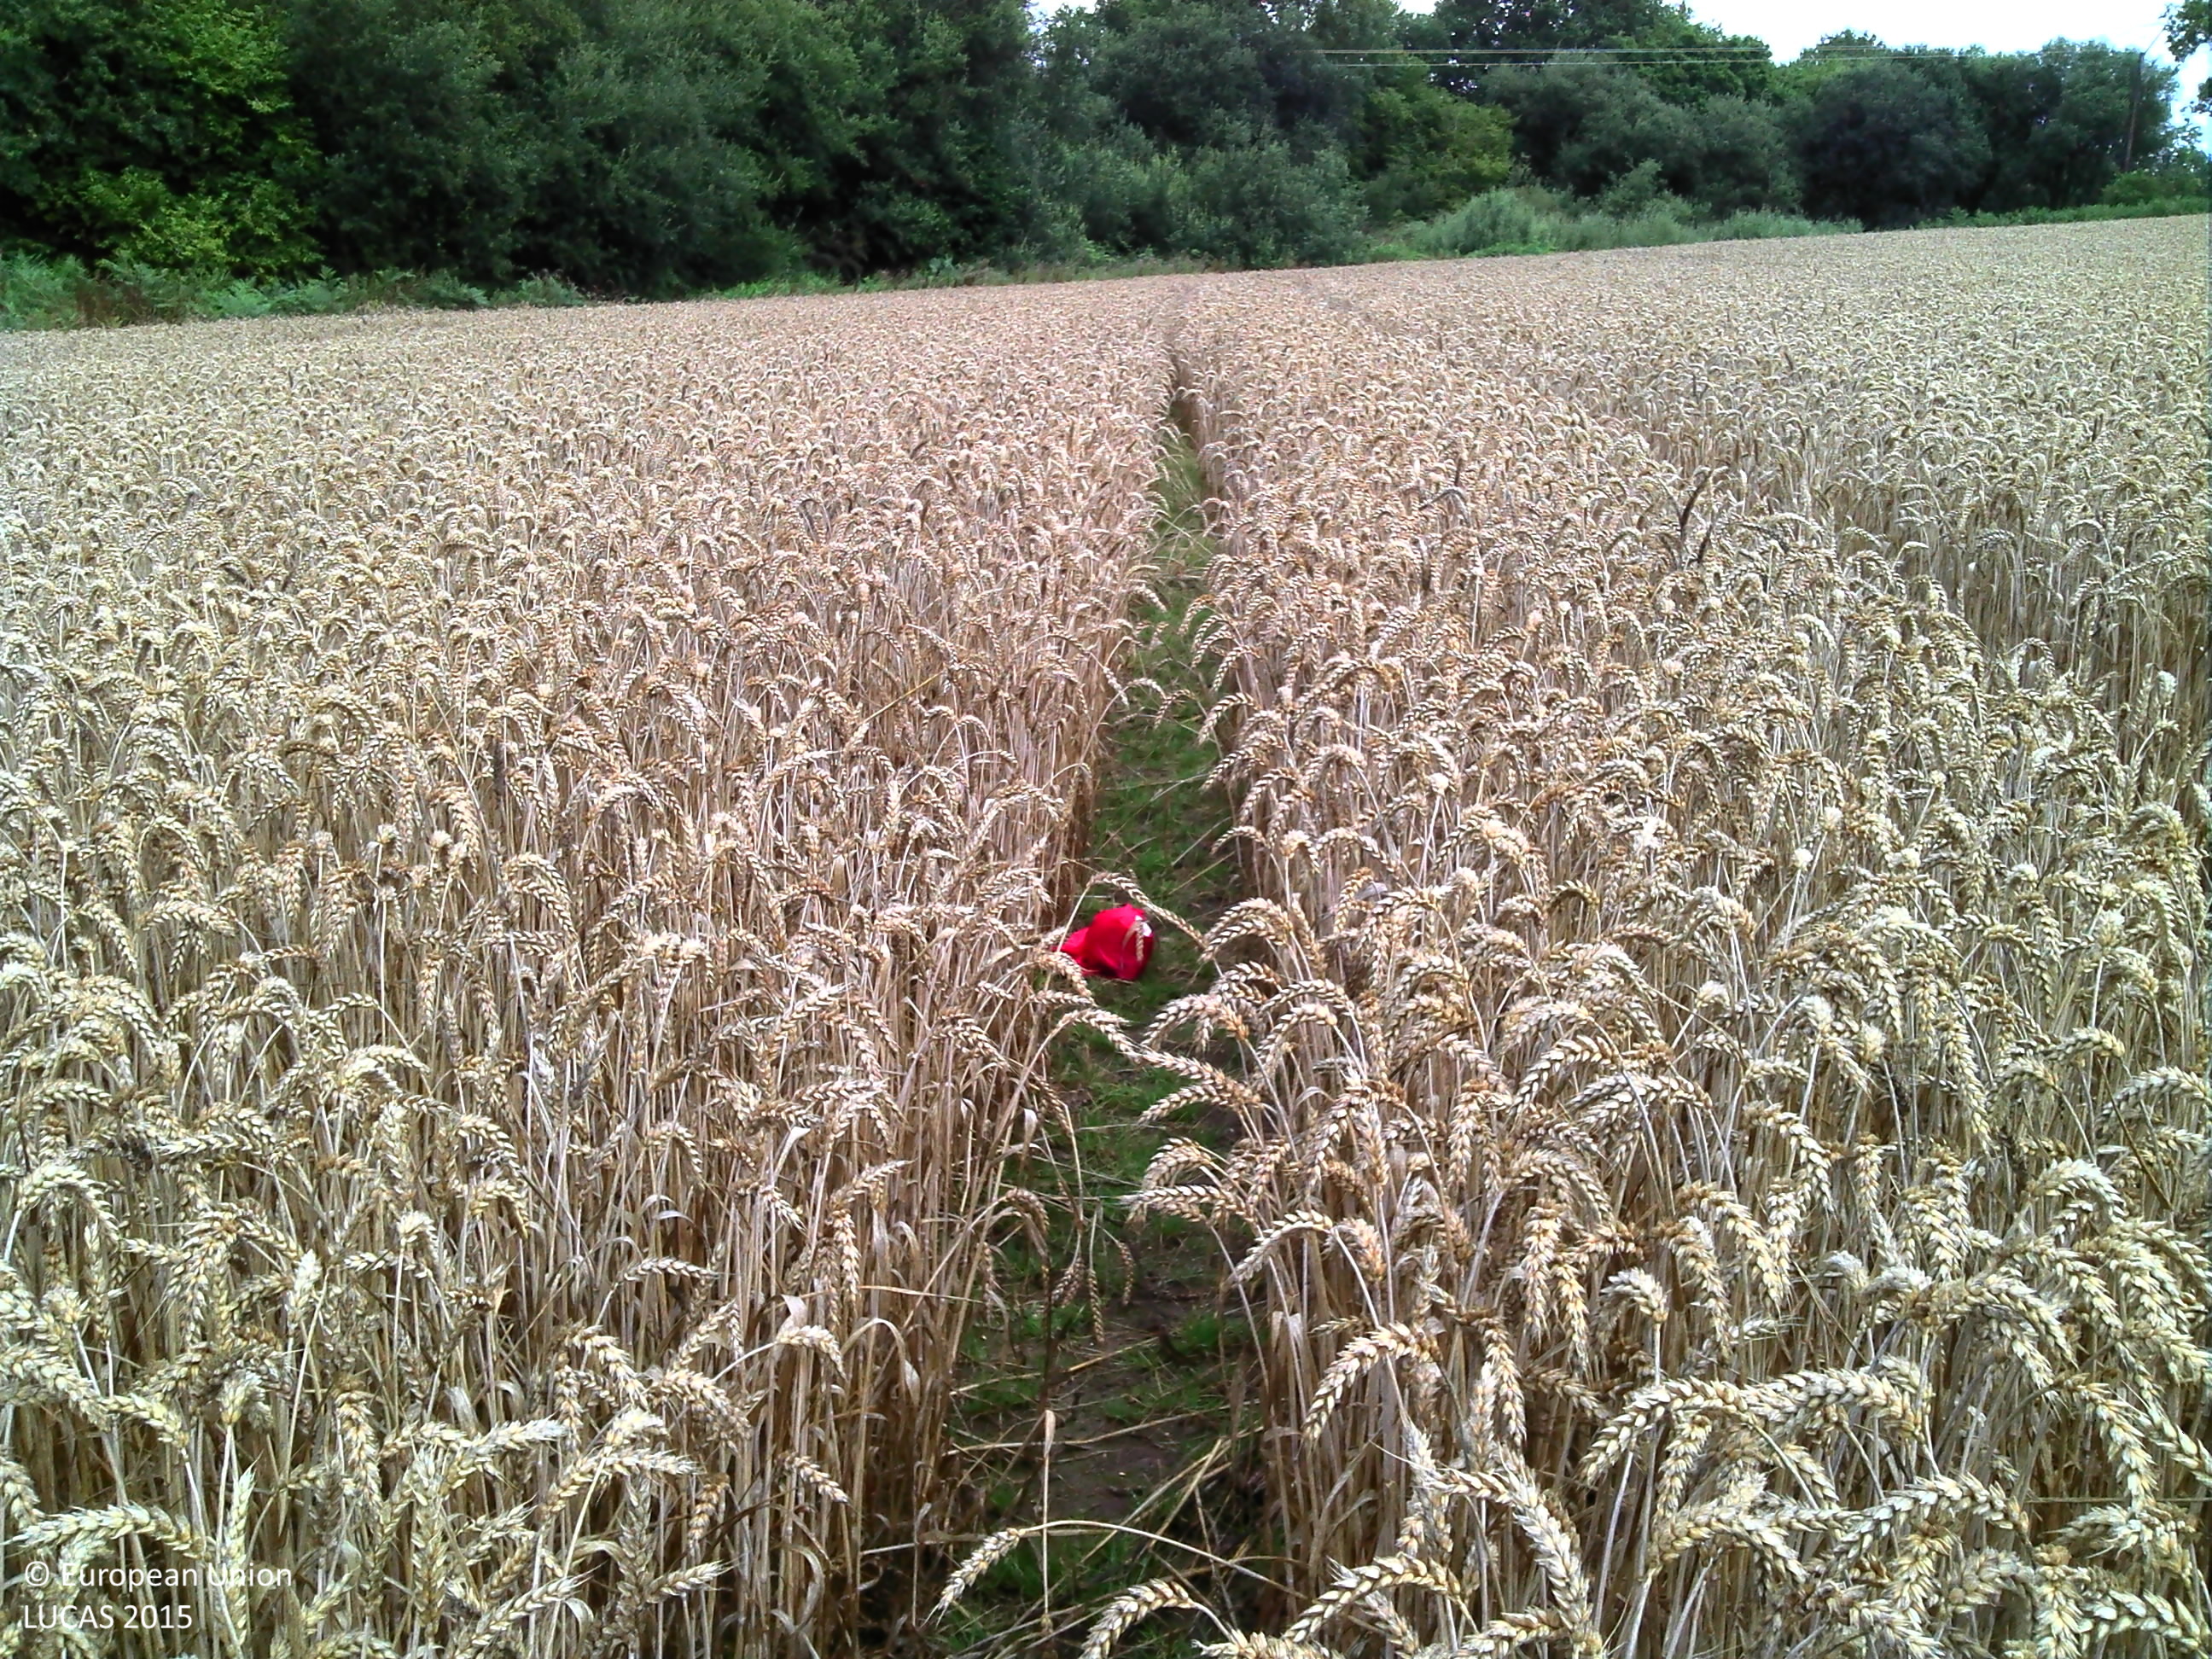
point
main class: Cropland
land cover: Common wheat
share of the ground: > 75 %
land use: Agriculture (excluding fallow land and kitchen gardens)
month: July
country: FR
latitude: 47.6460
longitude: -2.8834
